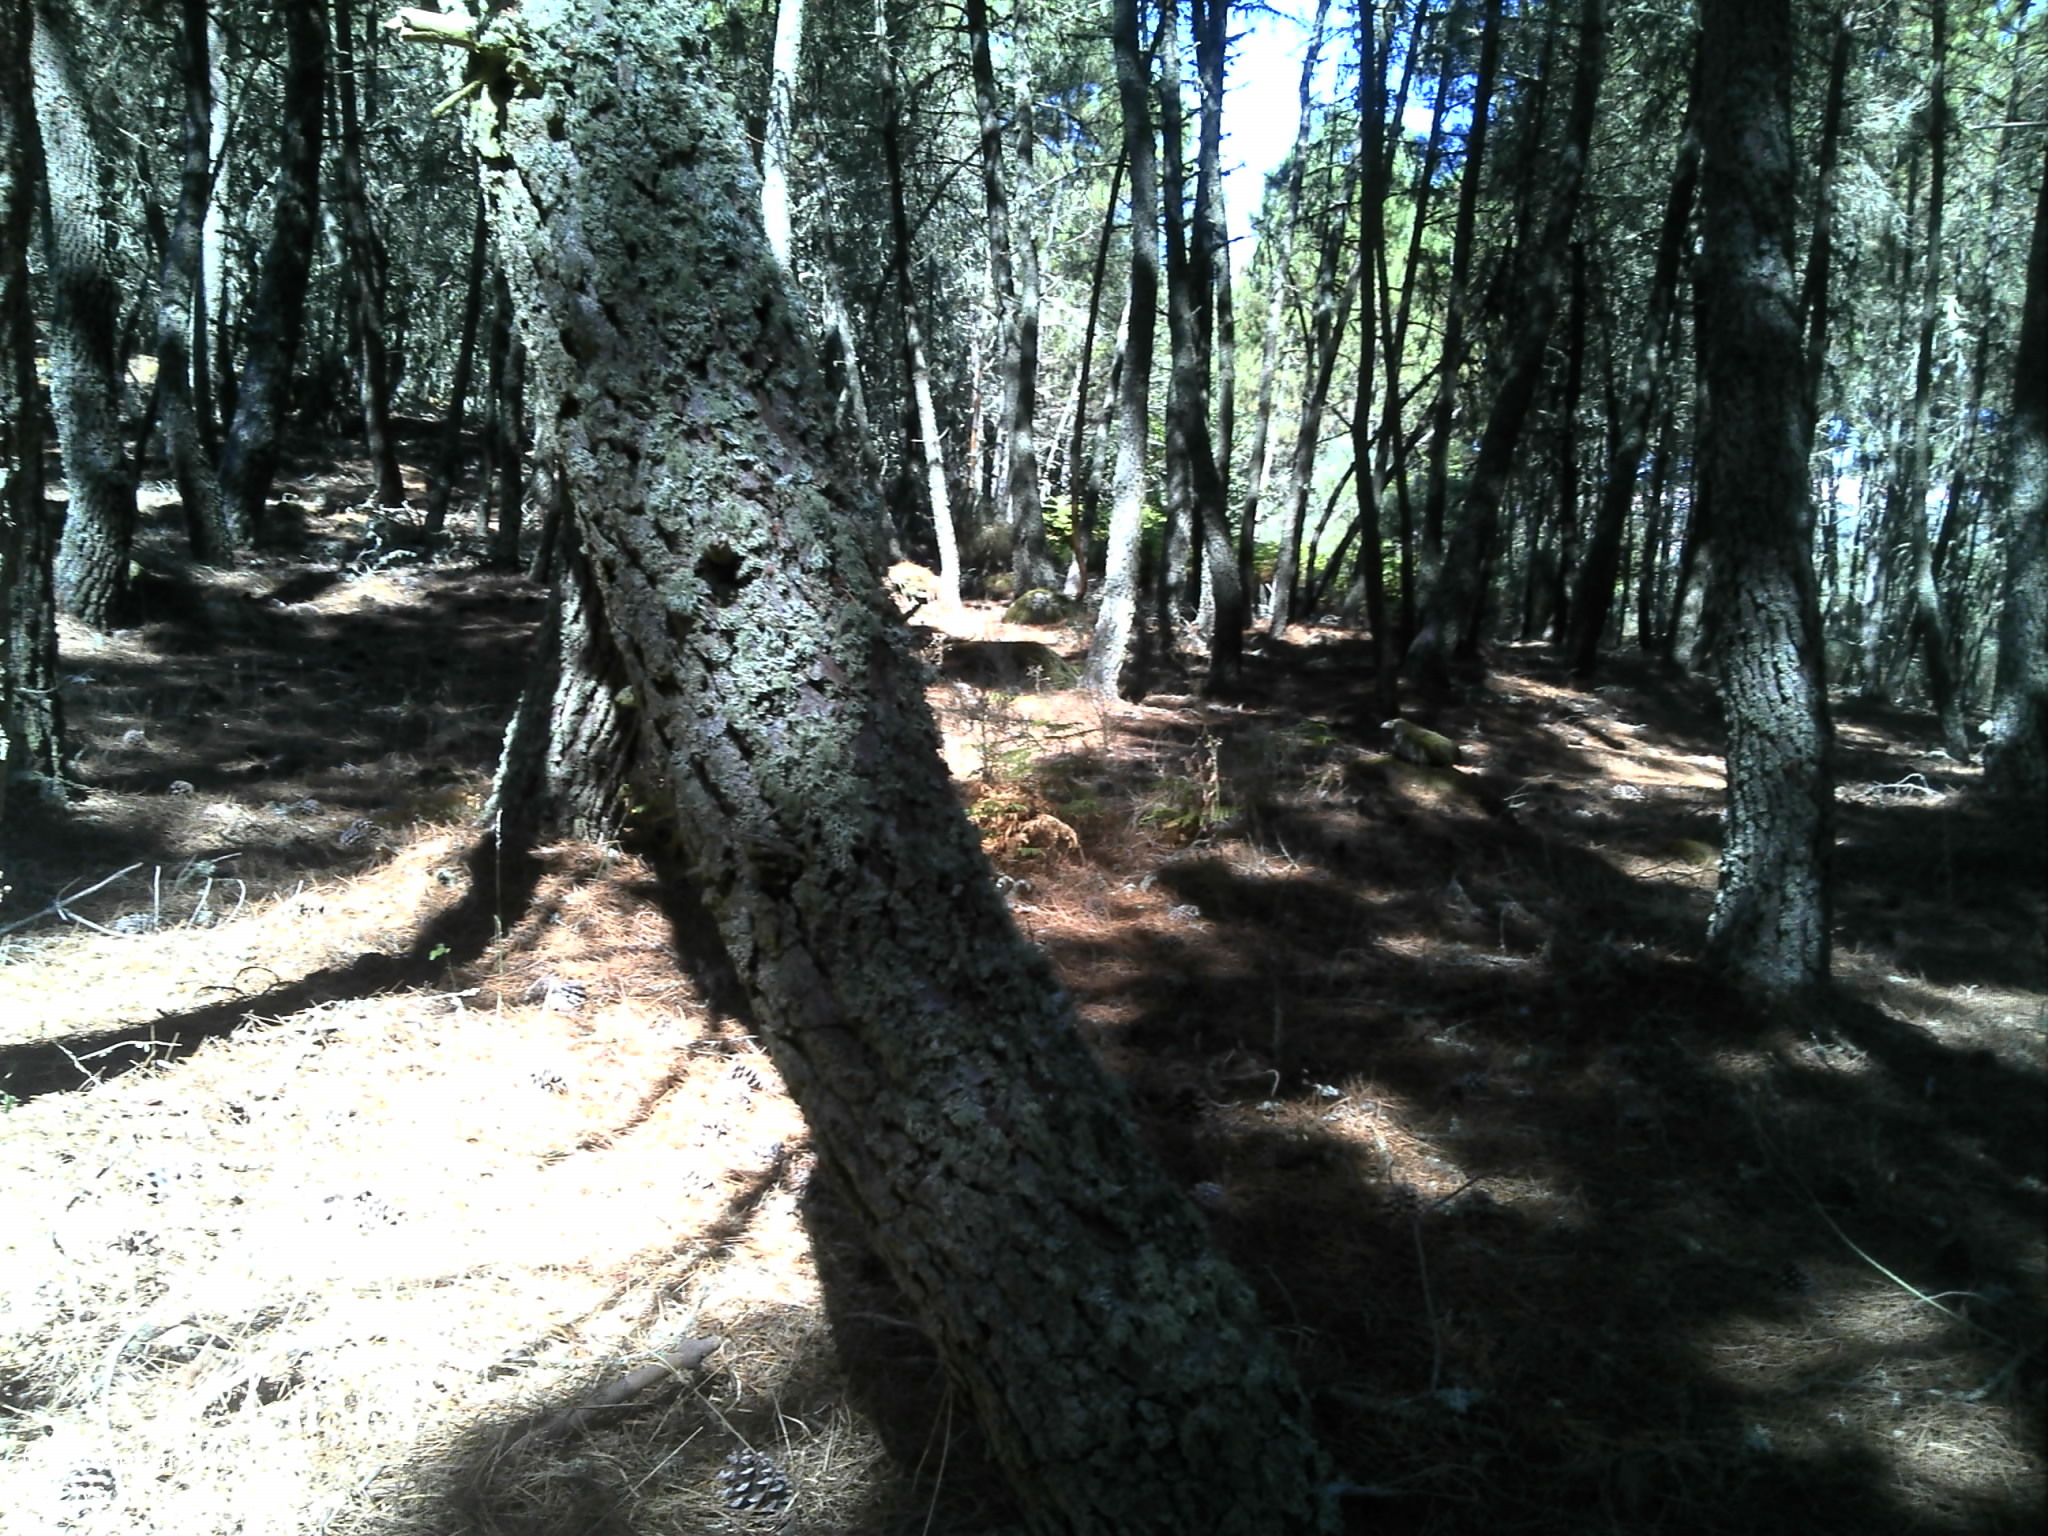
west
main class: Woodland
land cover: Pine dominated coniferous woodland
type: coniferous forest of the mediterranean region
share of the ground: < 10 %
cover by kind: unconsolidated bare surface 75 %, coniferous forest trees 20 %, shrubs 5 %
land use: Forestry
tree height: > 5 m
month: July
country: PT
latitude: 41.2285
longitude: -7.2844
